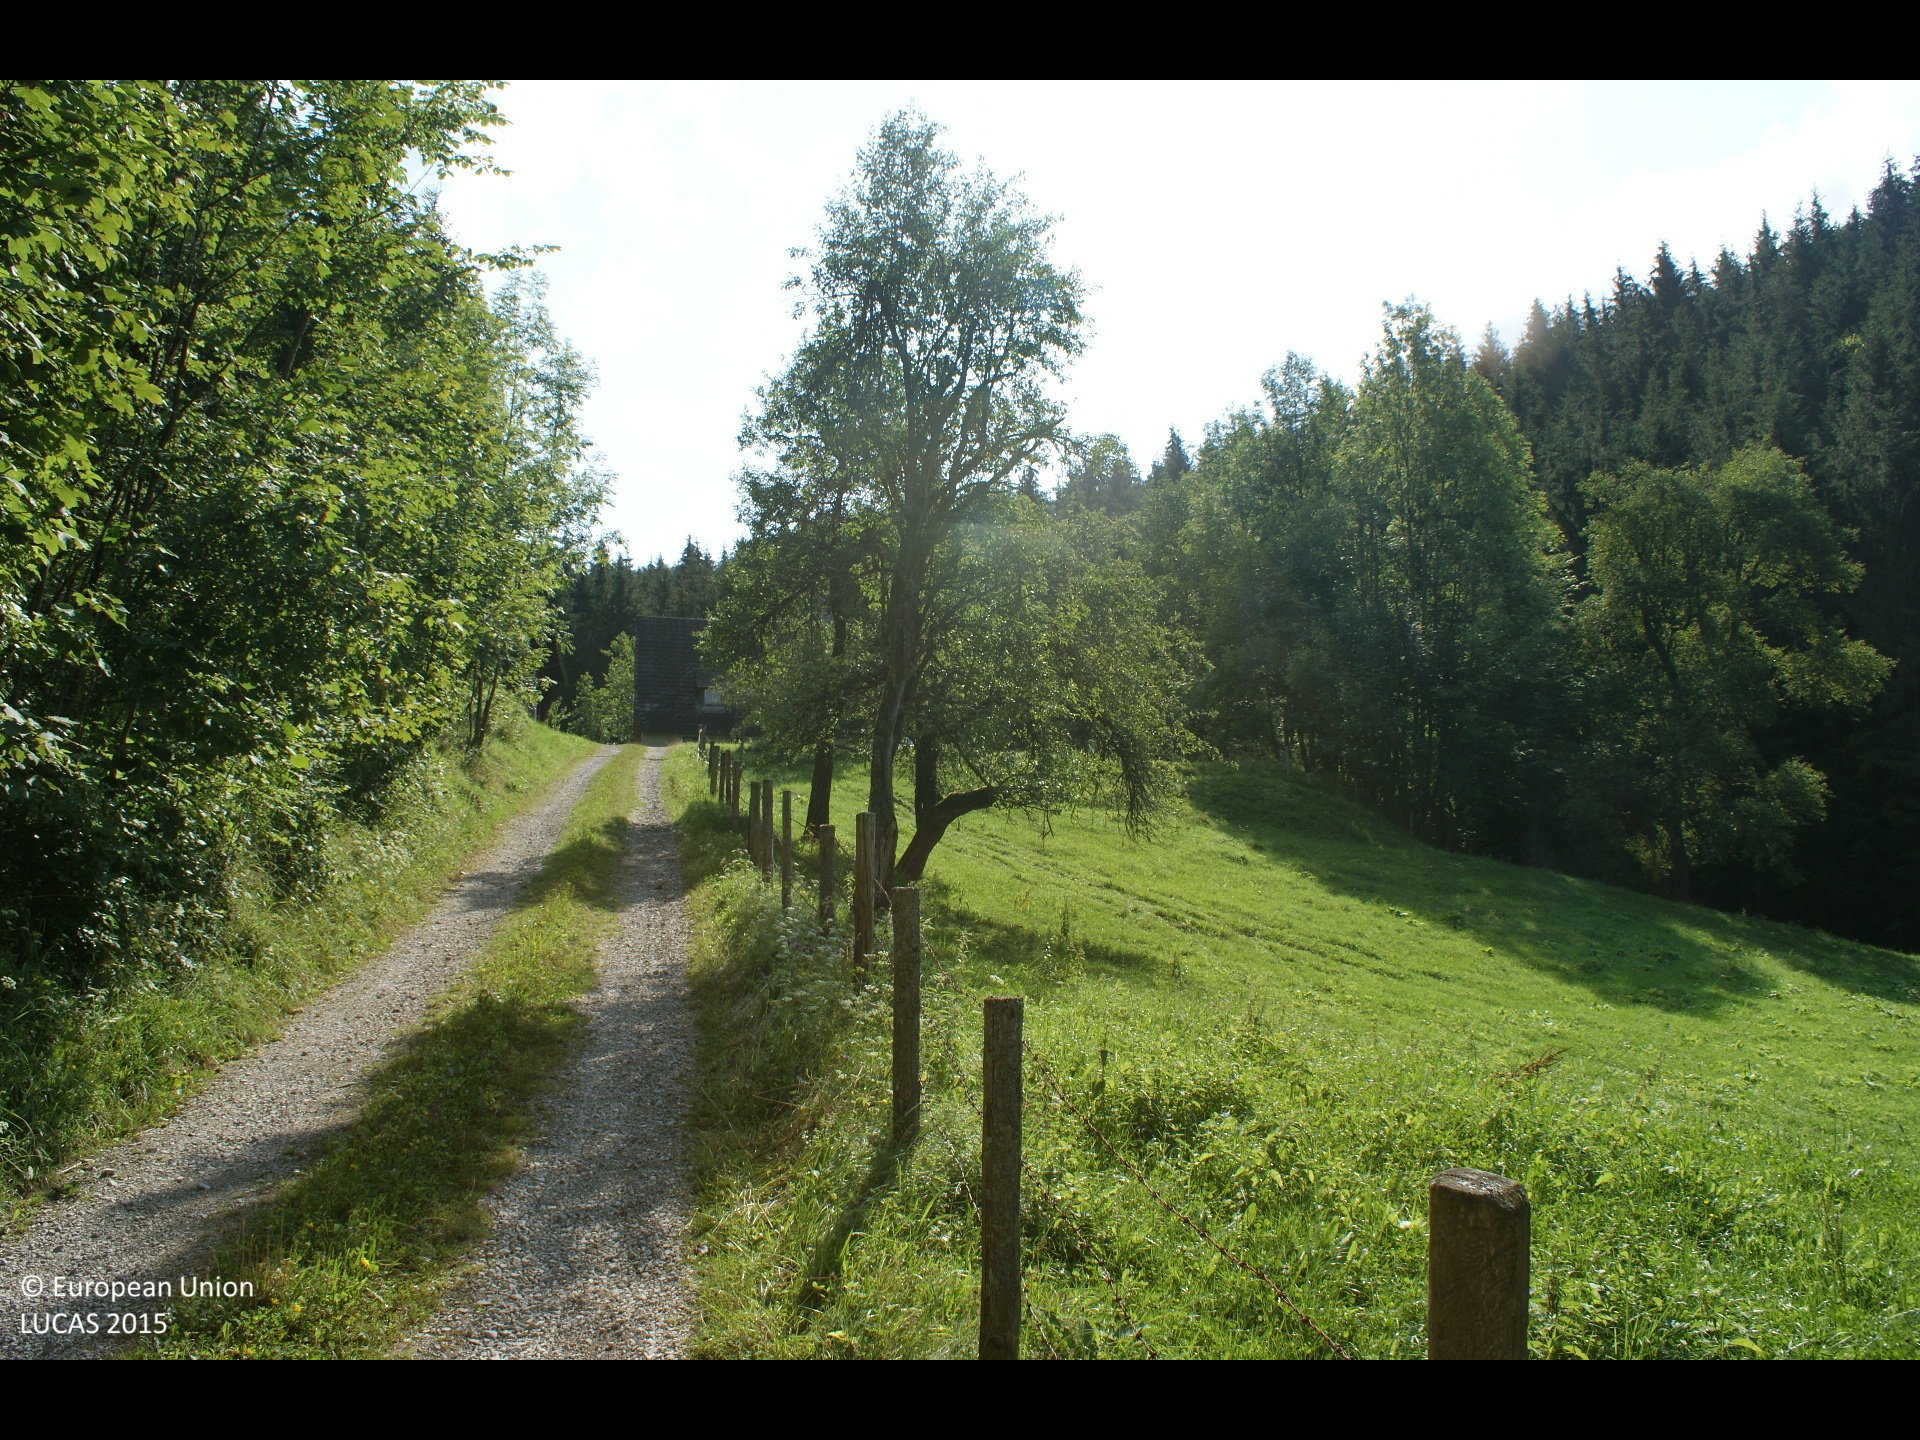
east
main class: Grassland
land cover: Grassland without tree/shrub cover
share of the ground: > 75 %
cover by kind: herbaceous plants 100 %
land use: Agriculture (excluding fallow land and kitchen gardens)
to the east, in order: Grassland without tree/shrub cover; Fences; Broadleaved woodland; Spontaneously vegetated surfaces; Broadleaved woodland; Spruce dominated coniferous woodland; Tracks; Grass margins; Fences; Broadleaved woodland; Fences; Spruce dominated coniferous woodland
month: July
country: AT
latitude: 47.8511
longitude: 14.7445
